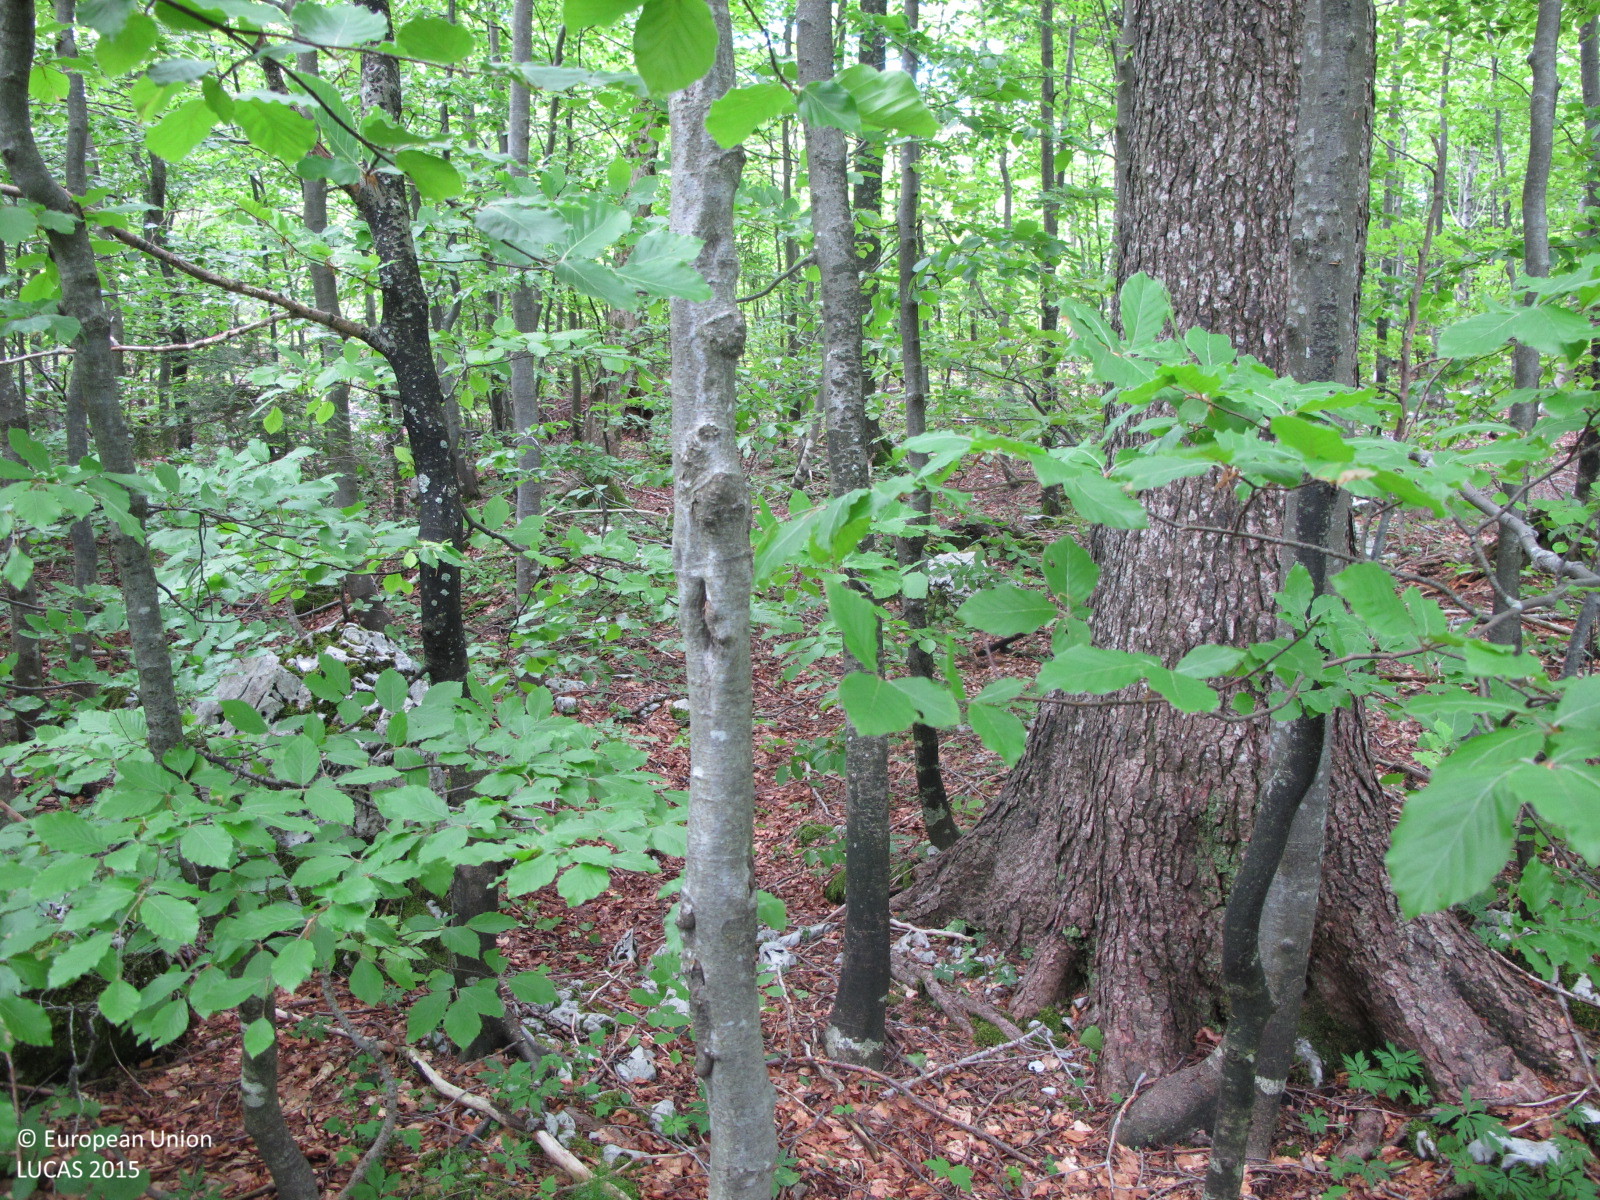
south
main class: Woodland
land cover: Broadleaved woodland
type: mountainous beech forest
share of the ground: > 75 %
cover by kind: broadleaved forest trees 80 %, coniferous forest trees 5 %, shrubs 5 %, herbaceous plants 5 %, consolidated bare surface 5 %
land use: Forestry
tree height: > 5 m
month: May
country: HR
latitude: 45.4421
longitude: 14.5593
